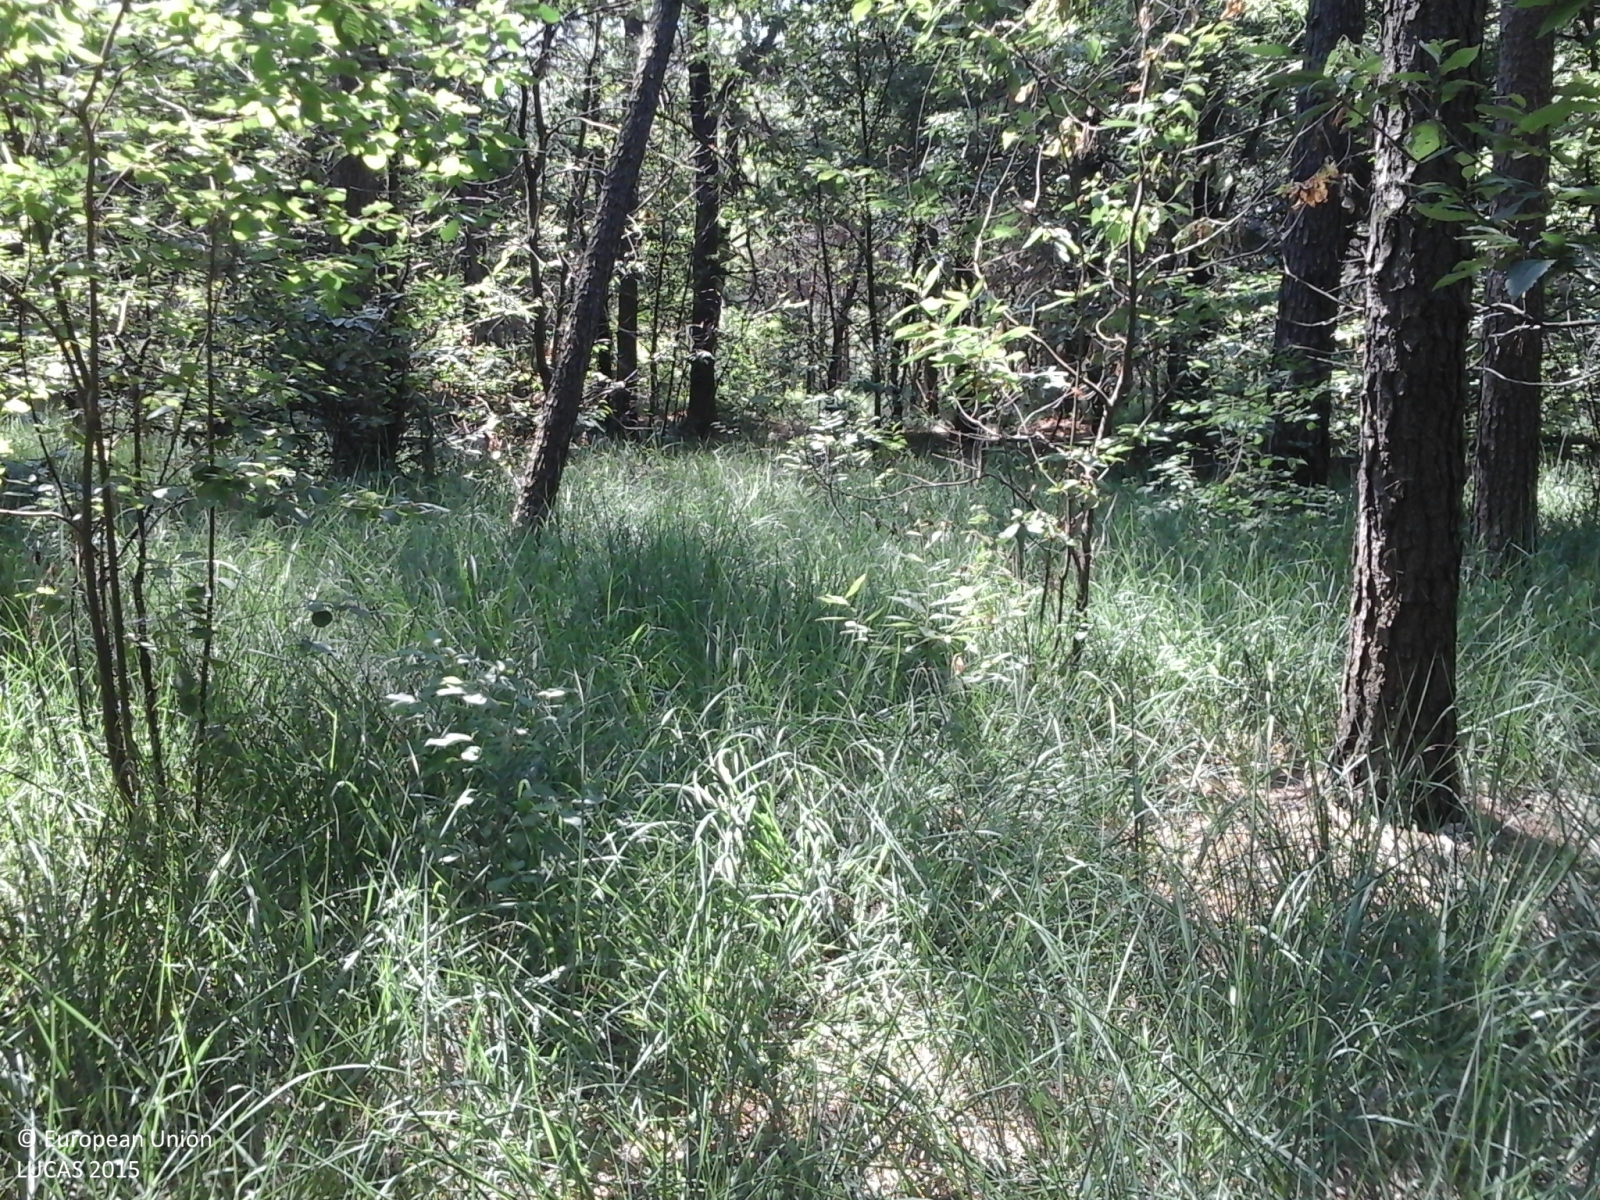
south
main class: Woodland
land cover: Pine dominated mixed woodland
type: thermophilous deciduous forest
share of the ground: > 75 %
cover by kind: coniferous forest trees 75 %, broadleaved forest trees 25 %
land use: Forestry
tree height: > 5 m
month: June
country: IT
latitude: 45.6587
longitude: 8.7059
